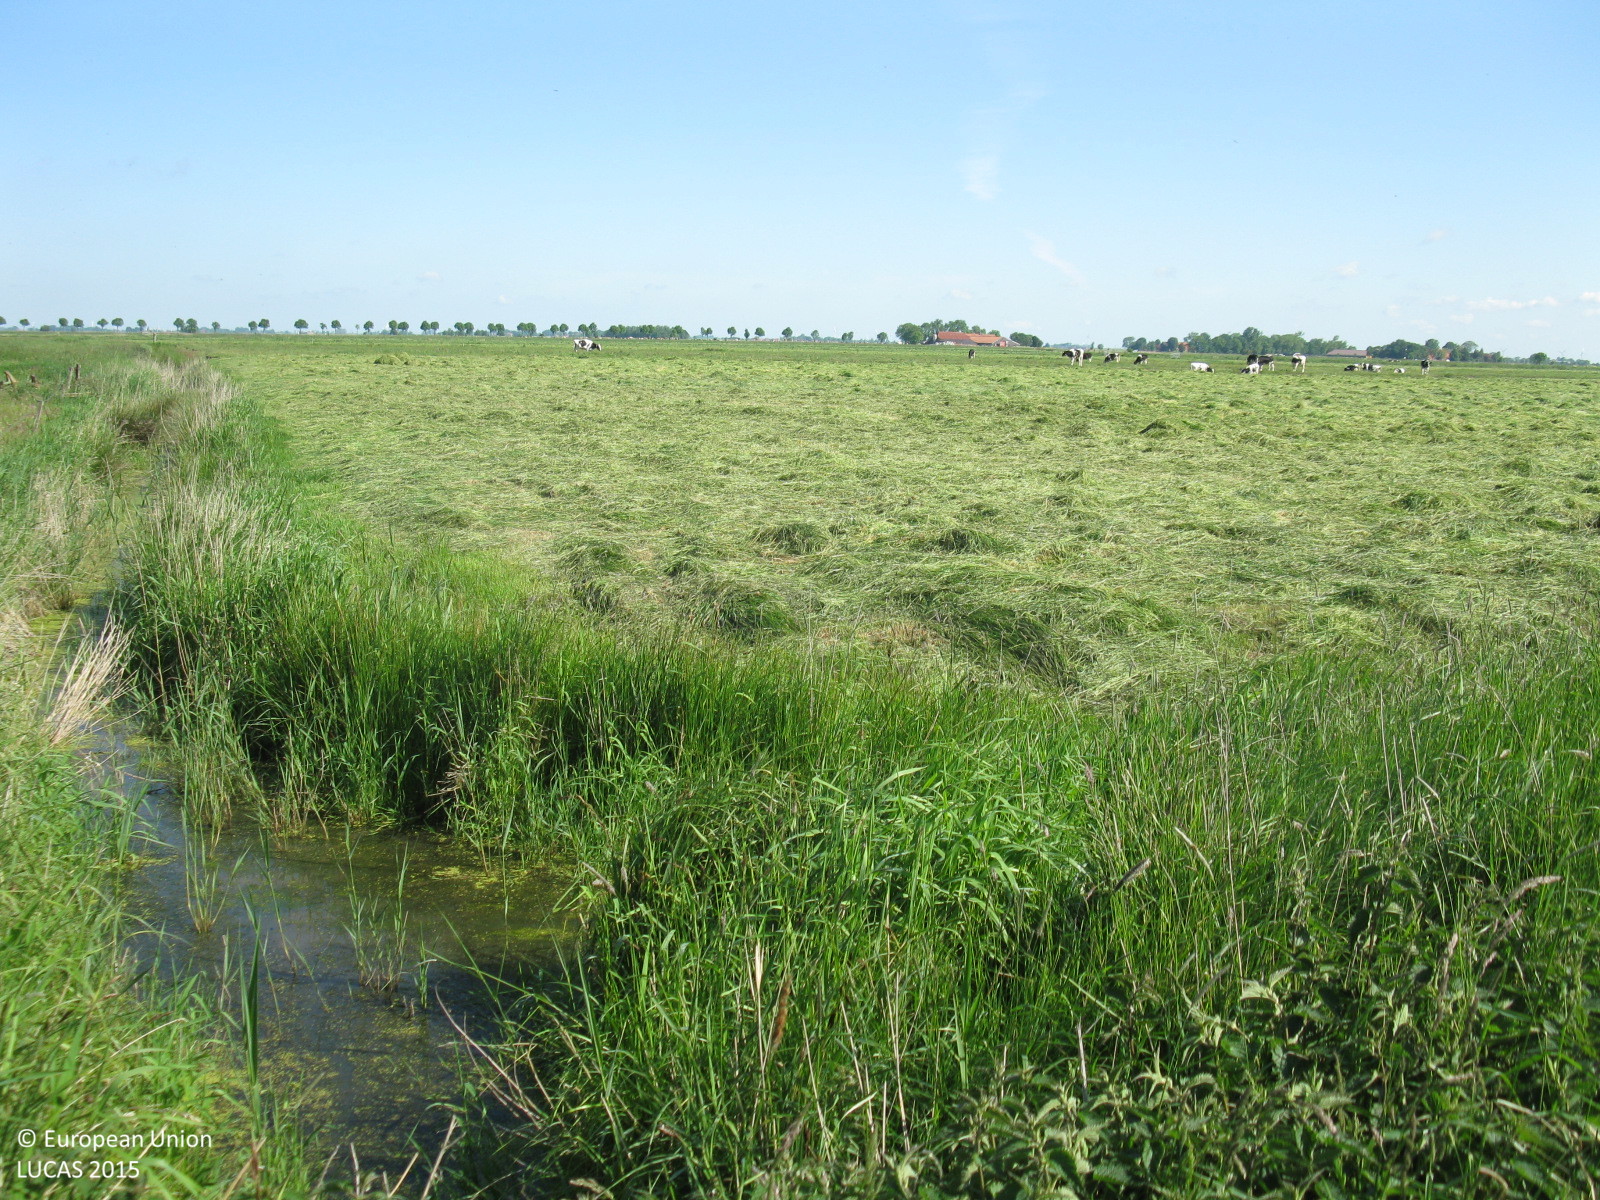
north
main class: Grassland
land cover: Grassland without tree/shrub cover
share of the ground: > 75 %
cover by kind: herbaceous plants 100 %
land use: Agriculture (excluding fallow land and kitchen gardens)
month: June
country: DE
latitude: 53.2471
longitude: 7.3480
